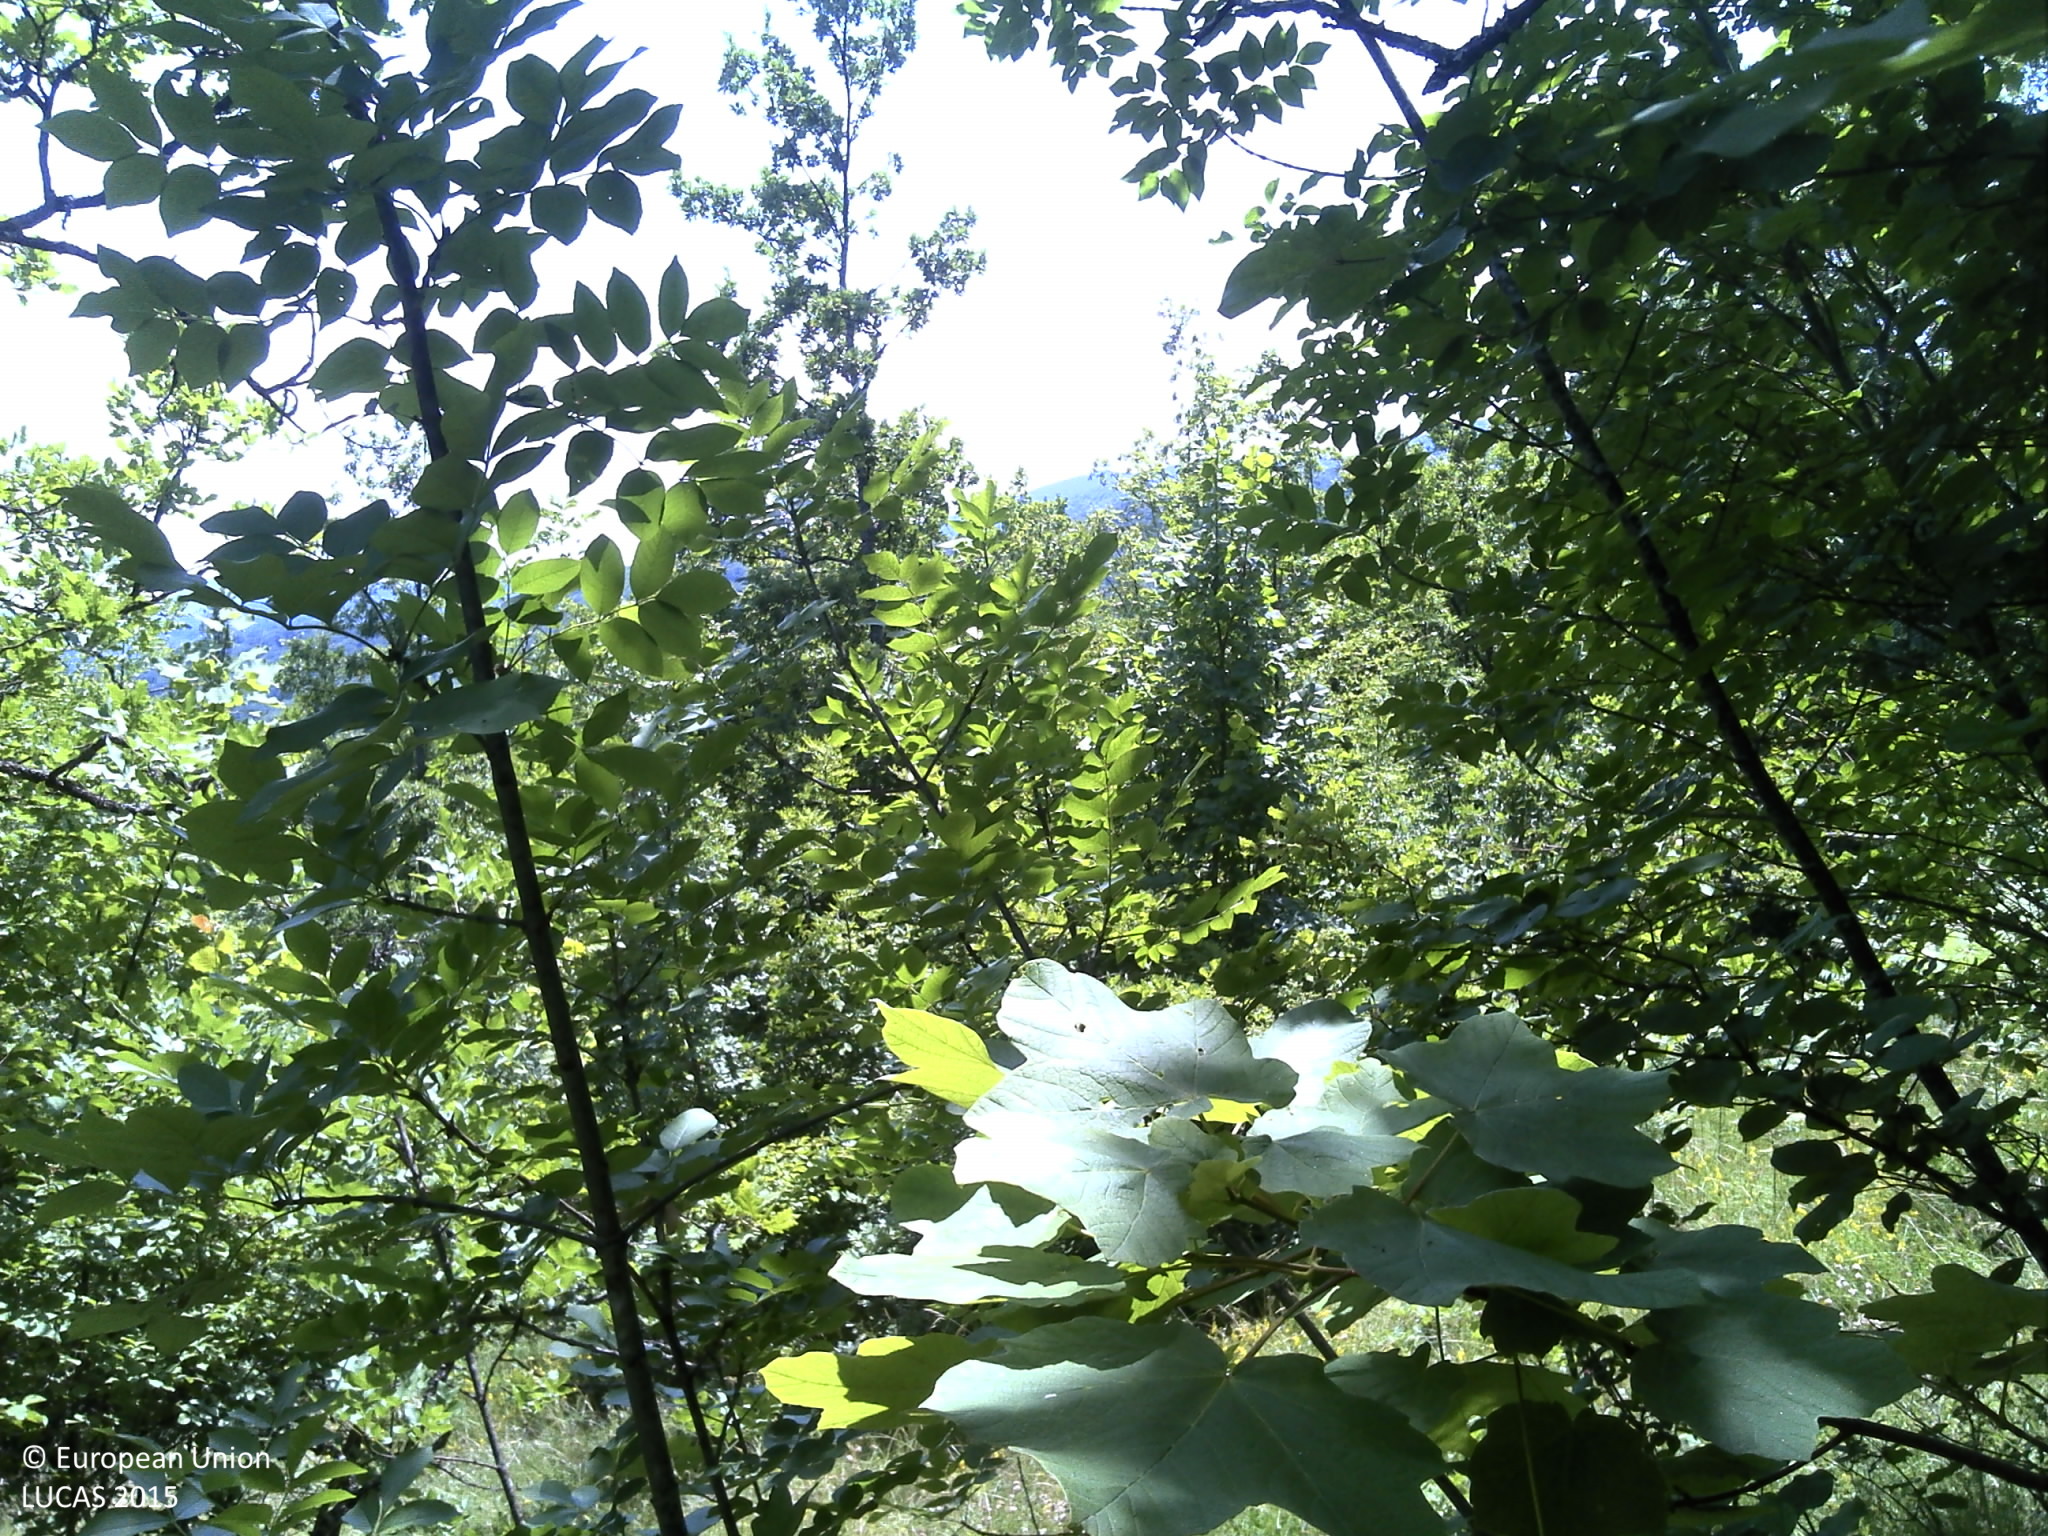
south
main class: Woodland
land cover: Broadleaved woodland
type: mountainous beech forest
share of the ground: > 75 %
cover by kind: broadleaved forest trees 90 %, herbaceous plants 10 %
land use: Forestry
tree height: > 5 m
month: June
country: HR
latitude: 44.5926
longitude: 16.0029
